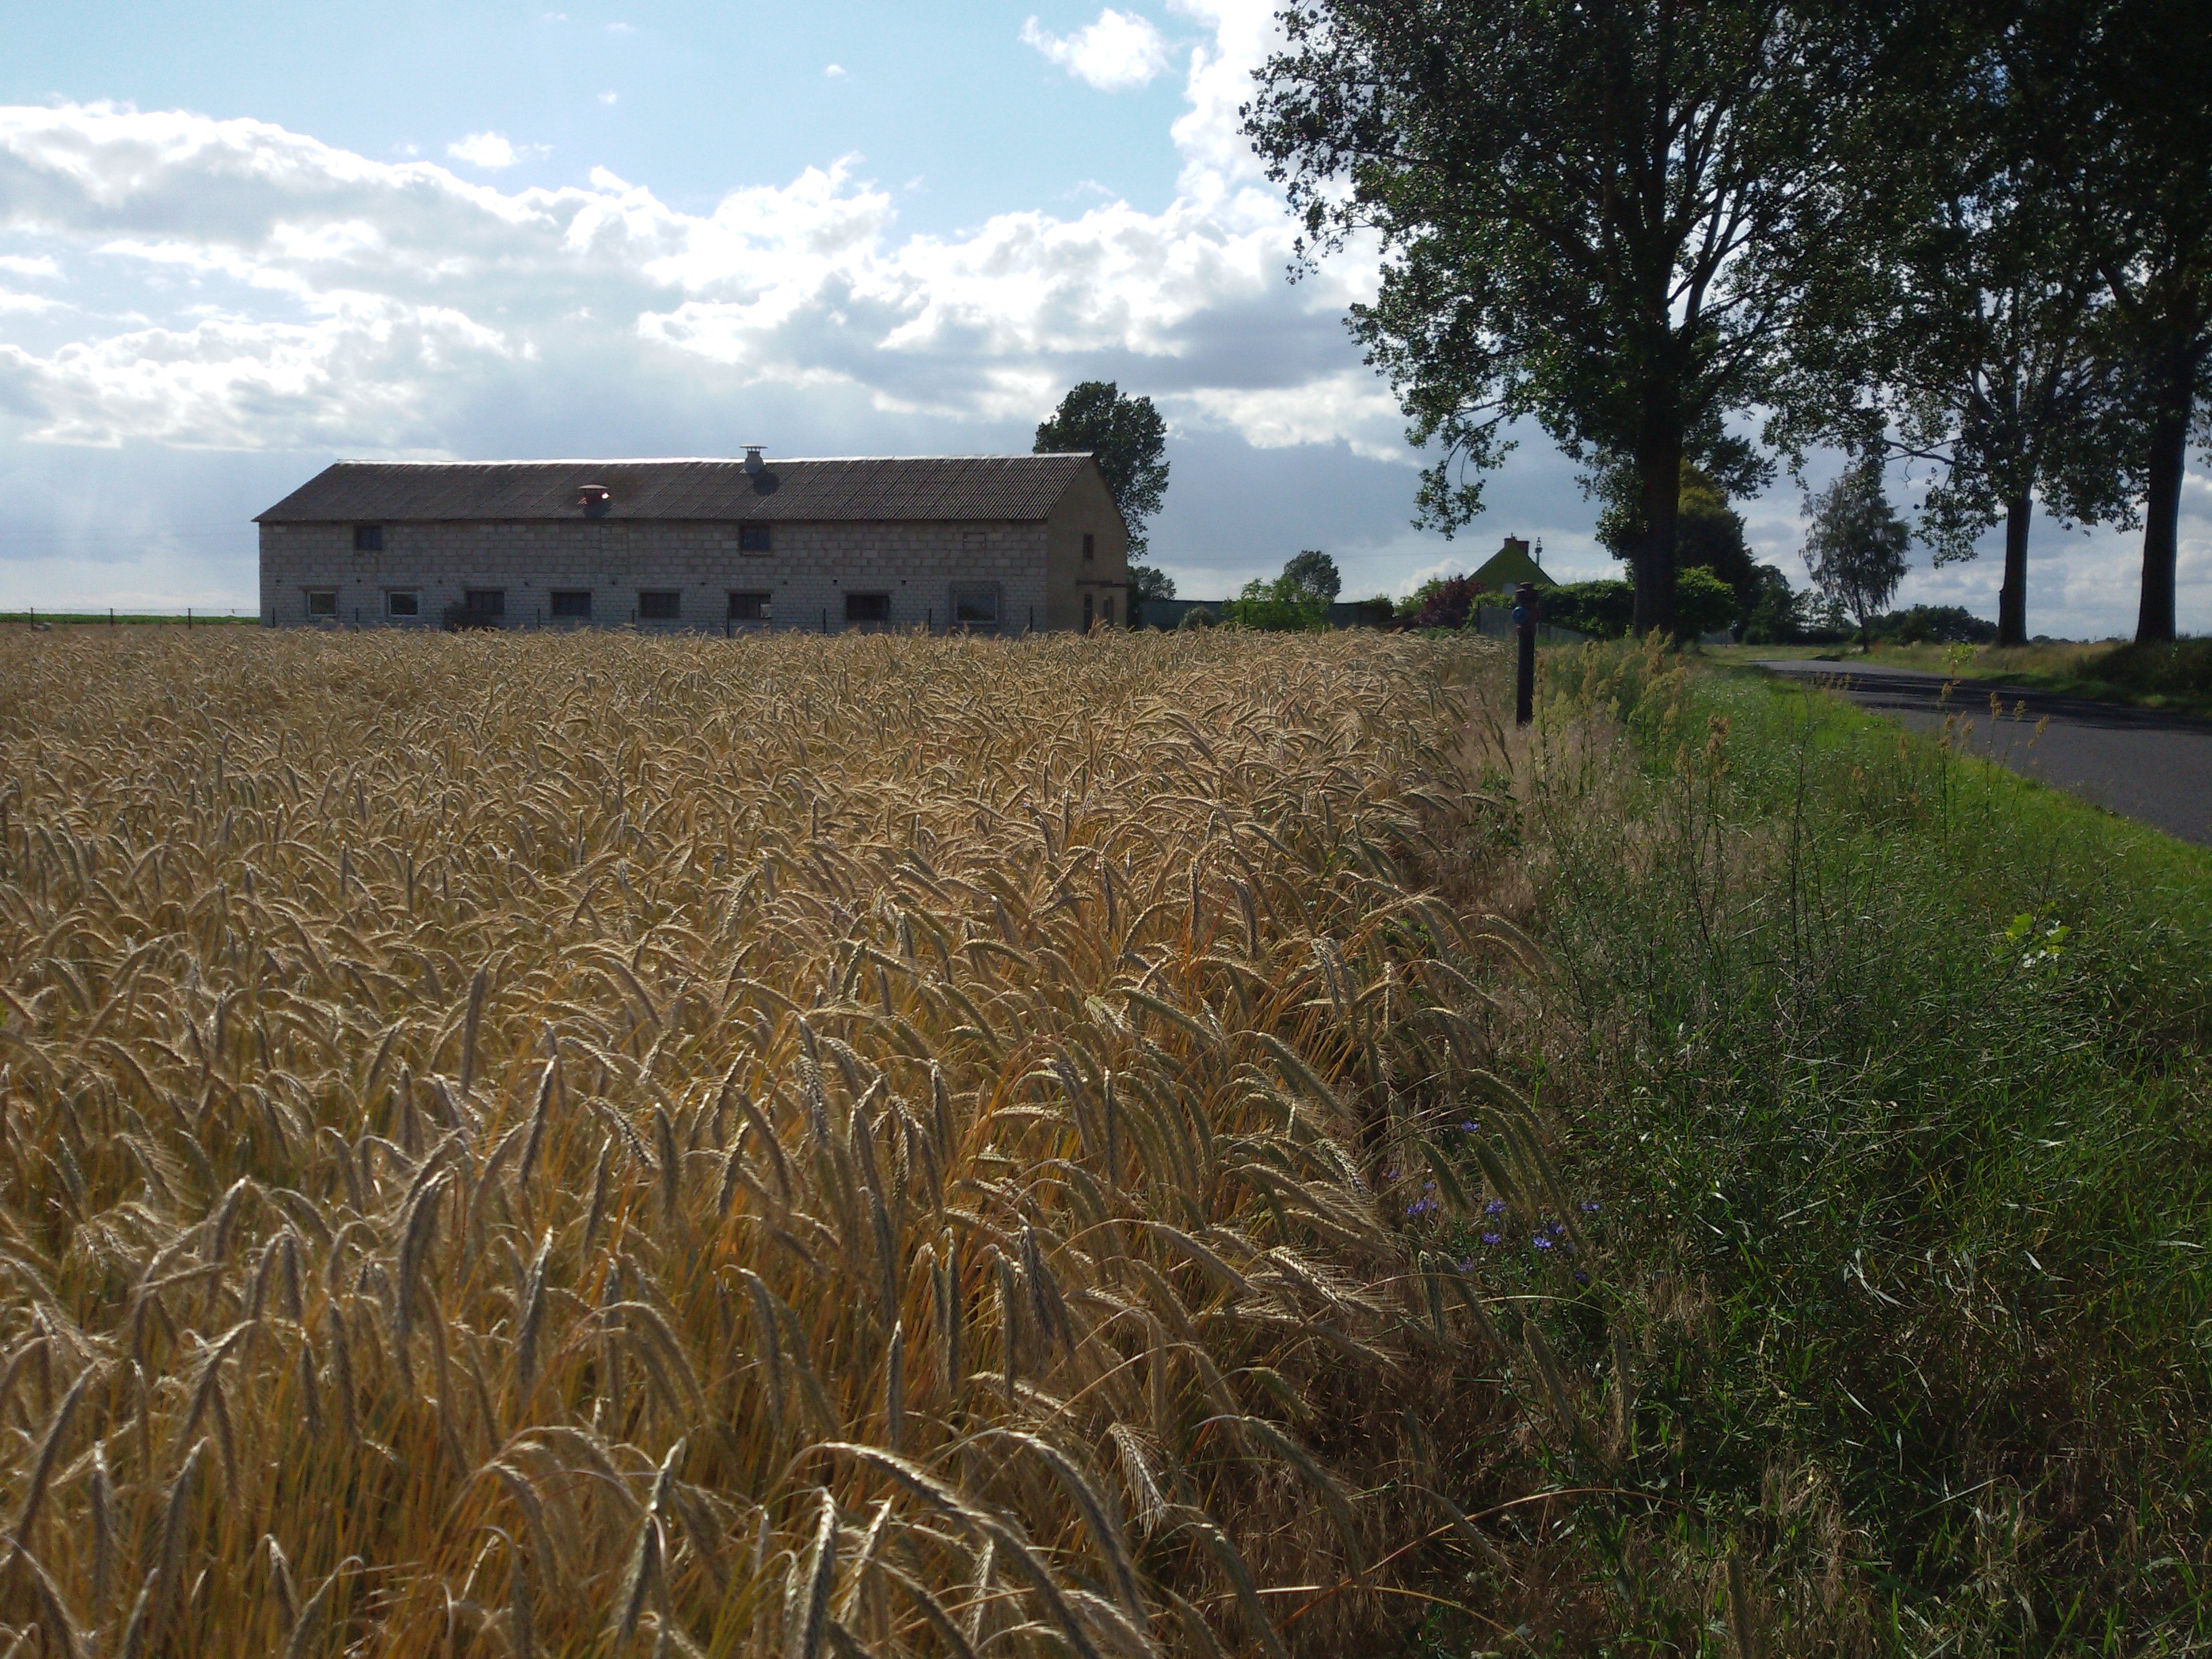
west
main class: Cropland
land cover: Triticale
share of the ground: > 75 %
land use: Agriculture (excluding fallow land and kitchen gardens)
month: July
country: PL
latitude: 52.7290
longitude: 17.6094
